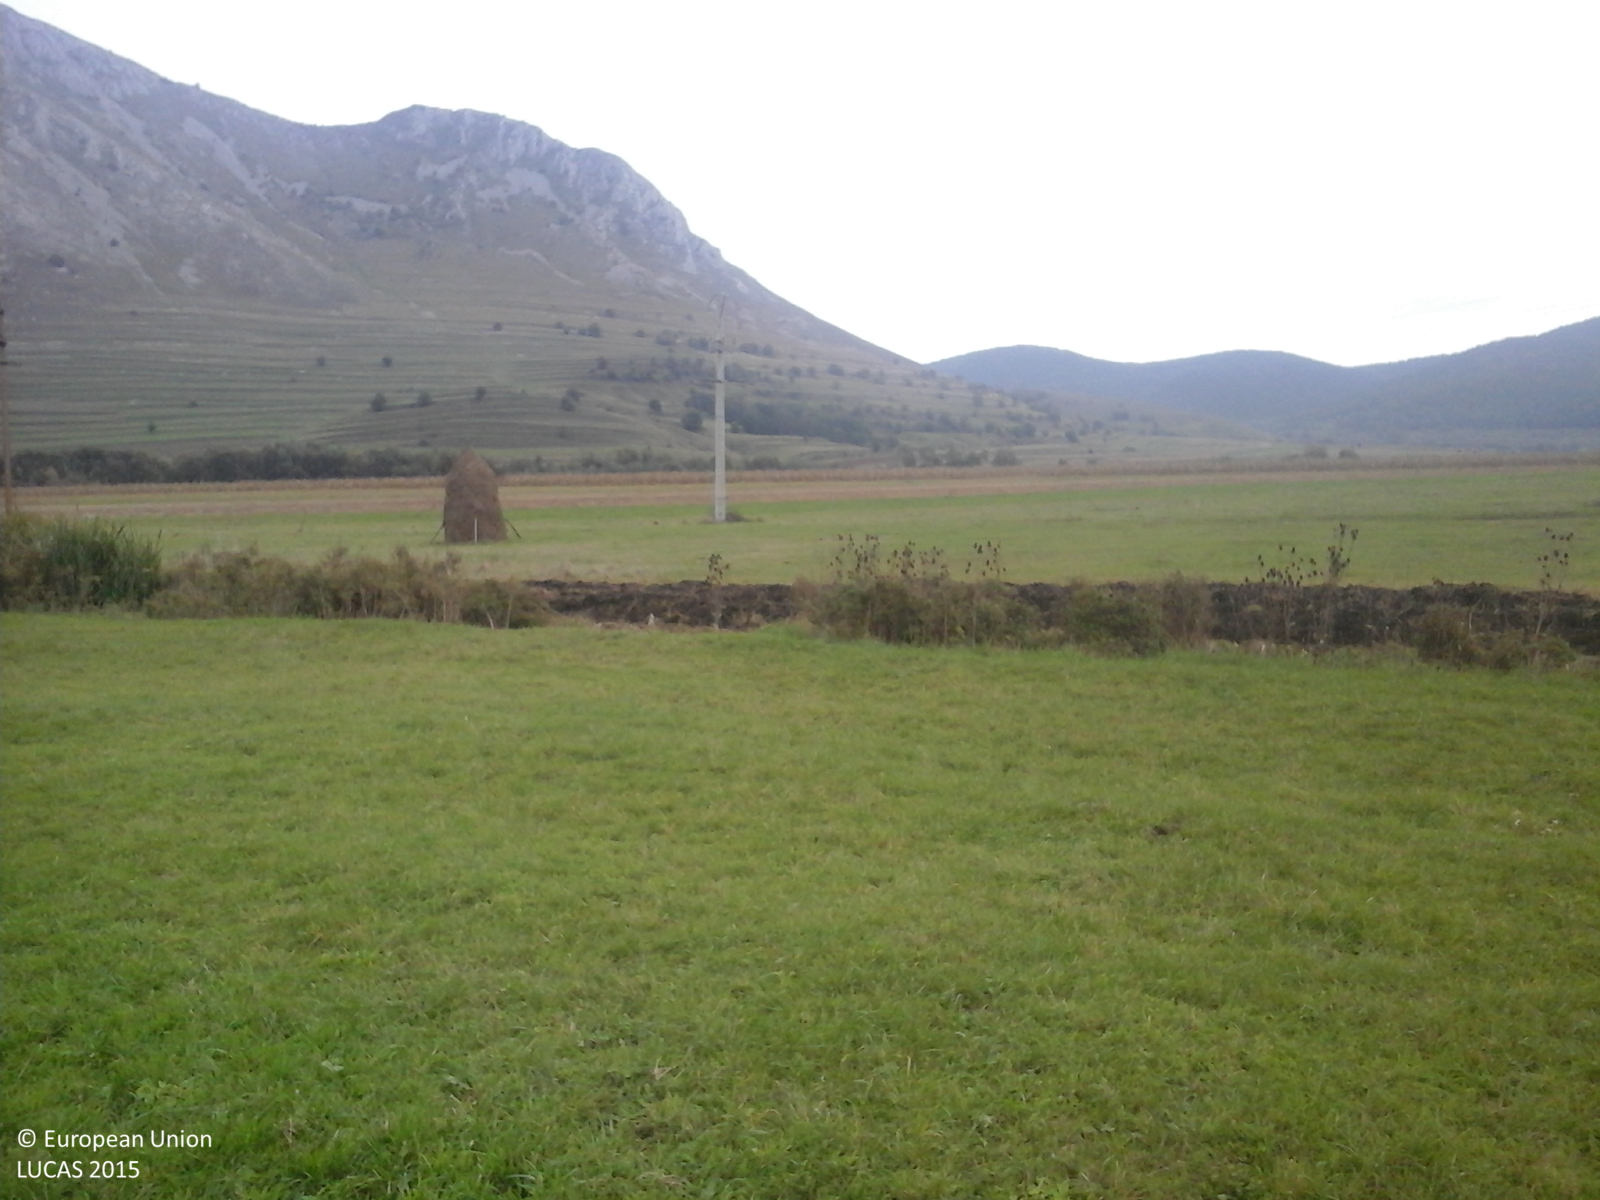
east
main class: Grassland
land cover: Grassland without tree/shrub cover
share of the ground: > 75 %
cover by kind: herbaceous plants 100 %
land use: Agriculture (excluding fallow land and kitchen gardens)
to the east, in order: Grassland without tree/shrub cover; Ditches and canals; Grassland without tree/shrub cover; Electric lines; Grassland without tree/shrub cover; Common wheat; Grassland without tree/shrub cover; Common wheat; Grassland without tree/shrub cover; Lucerne; Other fresh vegetables; Grassland without tree/shrub cover; Lucerne; Potatoes; Grassland without tree/shrub cover; Maize; Grassland without tree/shrub cover
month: October
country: RO
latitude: 46.4315
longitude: 23.5639
